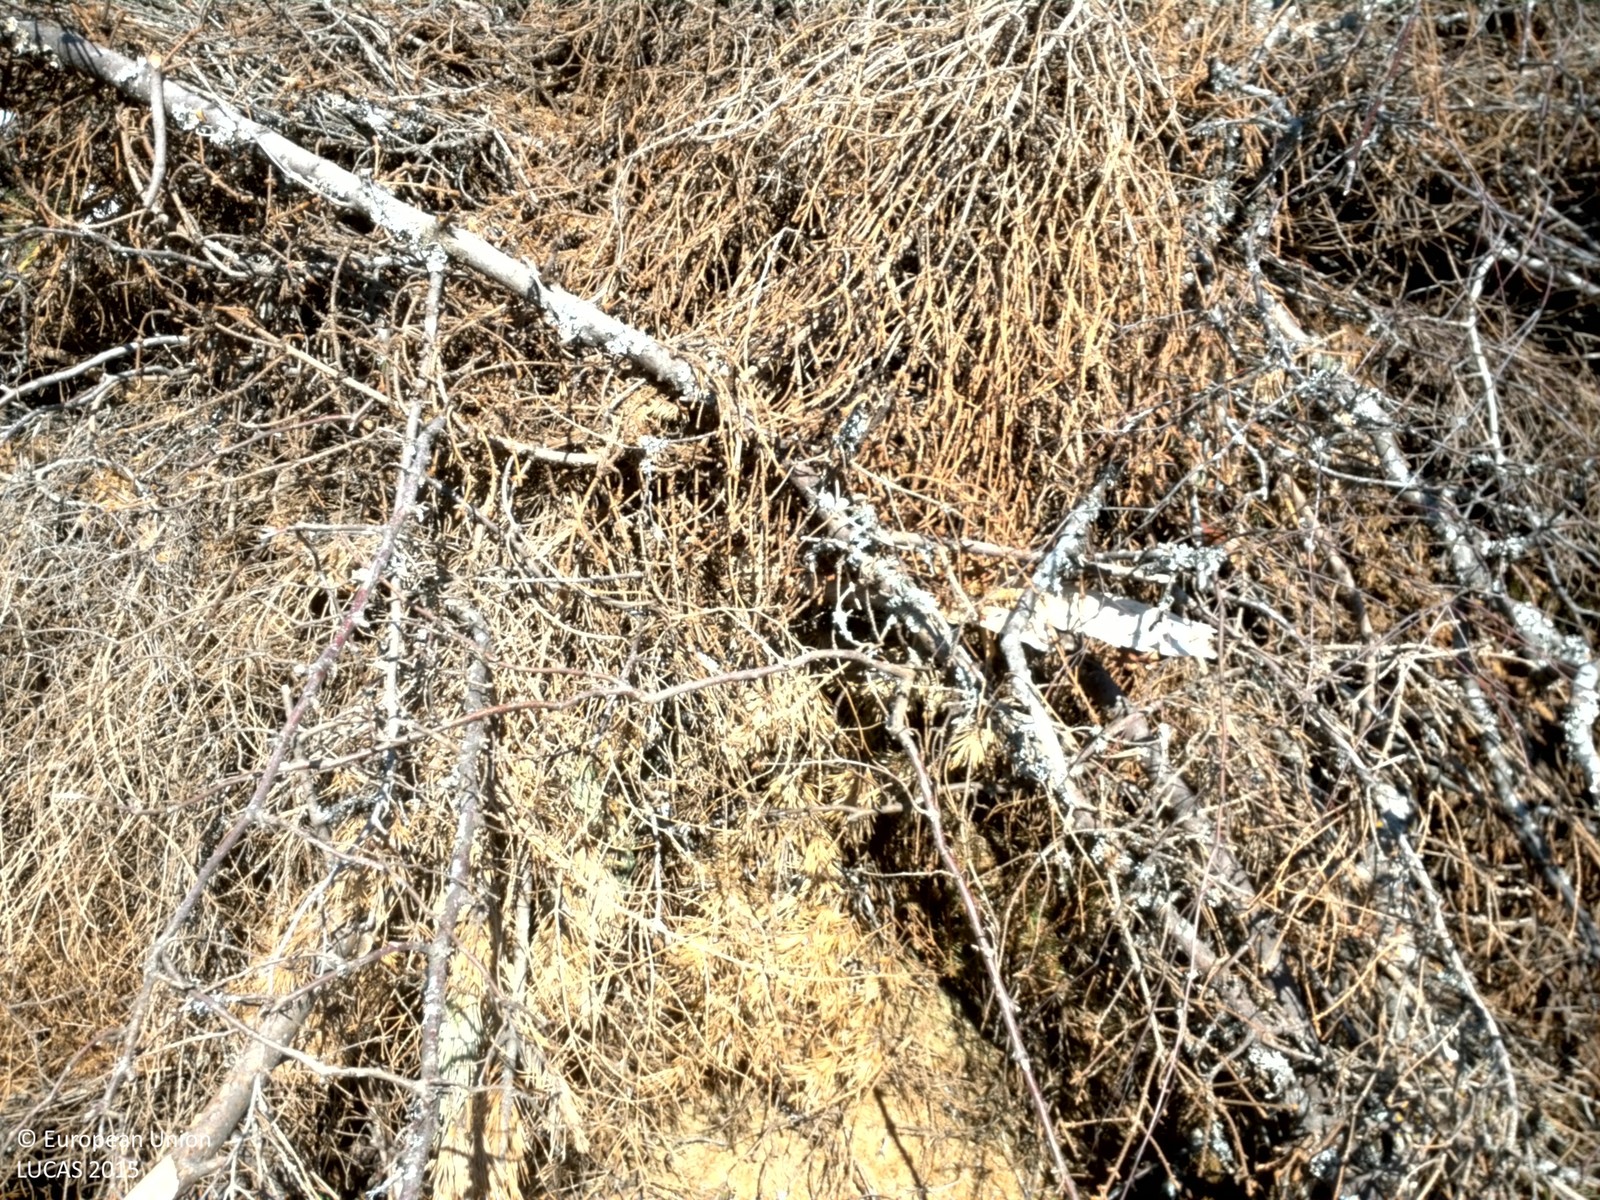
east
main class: Woodland
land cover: Spruce dominated coniferous woodland
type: boreal forest
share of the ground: 10 - 25 %
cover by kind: consolidated bare surface 80 %, coniferous forest trees 10 %, herbaceous plants 10 %
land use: Forestry
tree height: < 5 m
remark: Clear cut
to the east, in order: Spruce dominated coniferous woodland; Paved roads, cycling and walking lanes; Grassland with sparse tree/shrub cover; Spruce dominated coniferous woodland; Pine dominated coniferous woodland; Spruce dominated coniferous woodland; Pine dominated coniferous woodland; Spruce dominated coniferous woodland
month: June
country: SE
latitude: 58.5725
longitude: 15.5823
